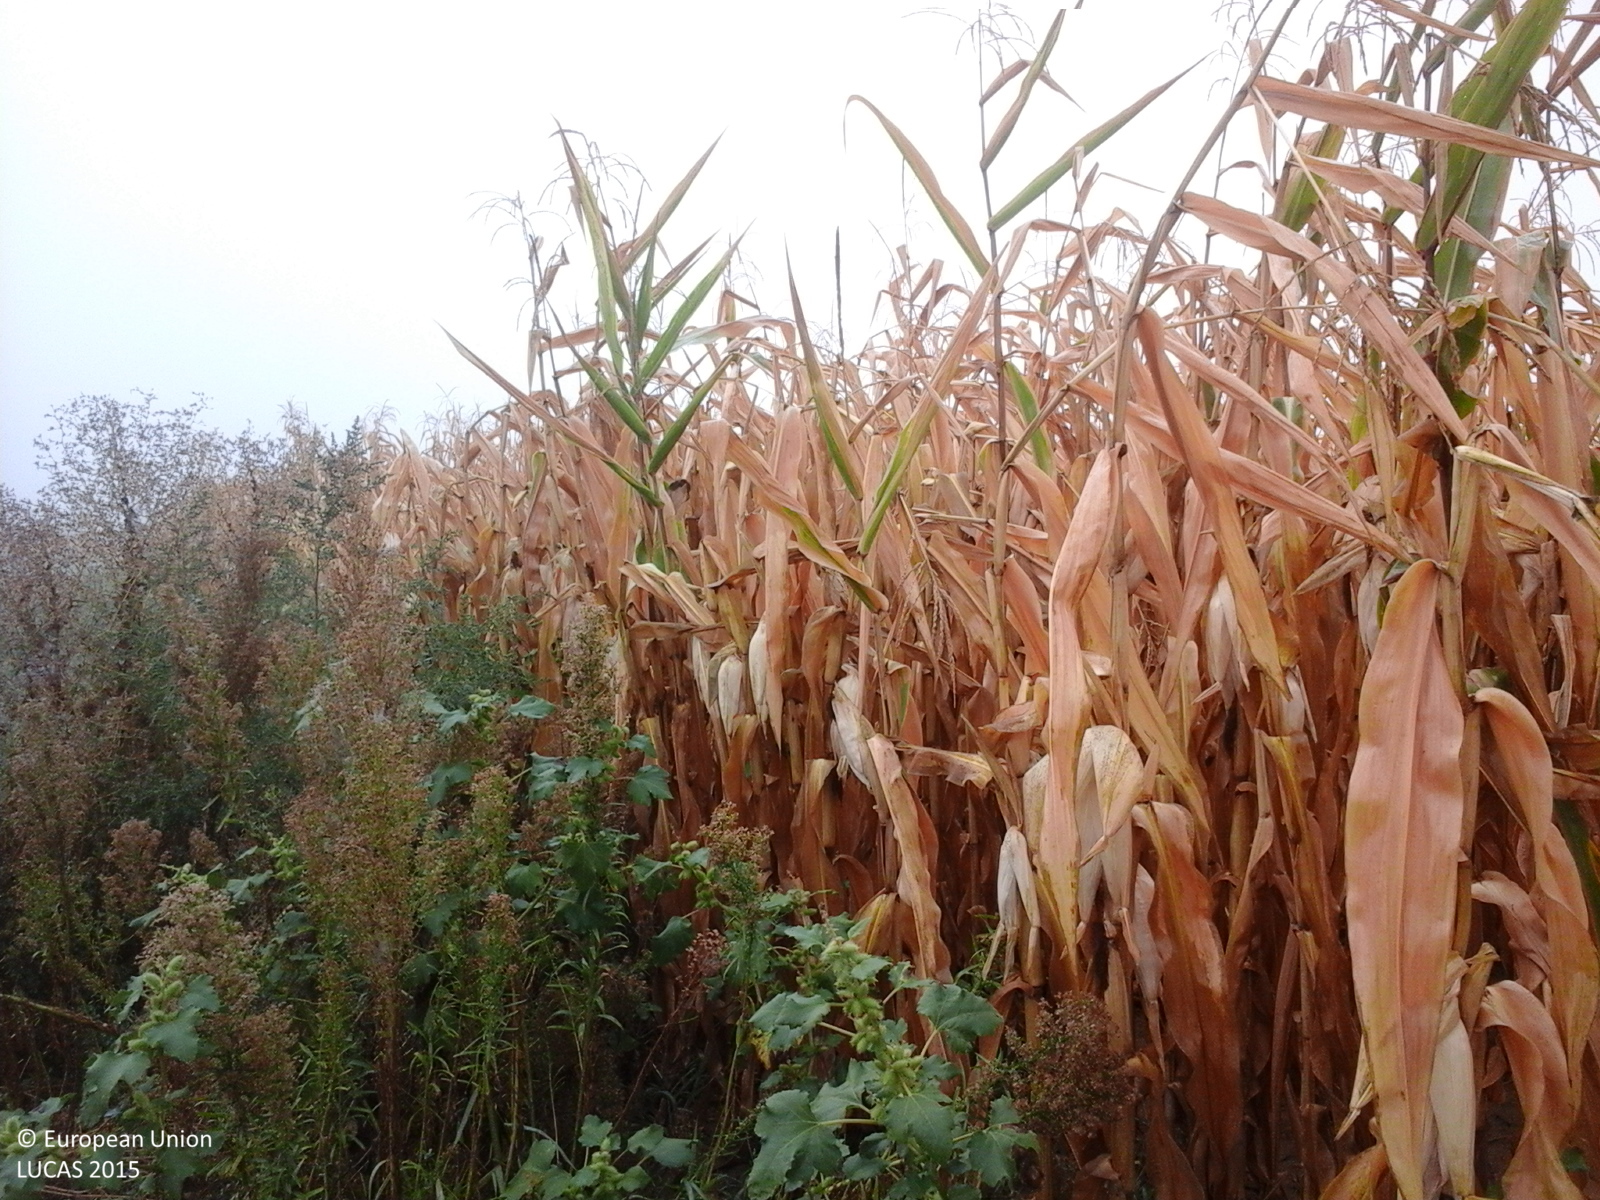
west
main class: Cropland
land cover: Maize
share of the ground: > 75 %
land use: Agriculture (excluding fallow land and kitchen gardens)
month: September
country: RO
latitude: 47.8120
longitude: 23.1702
